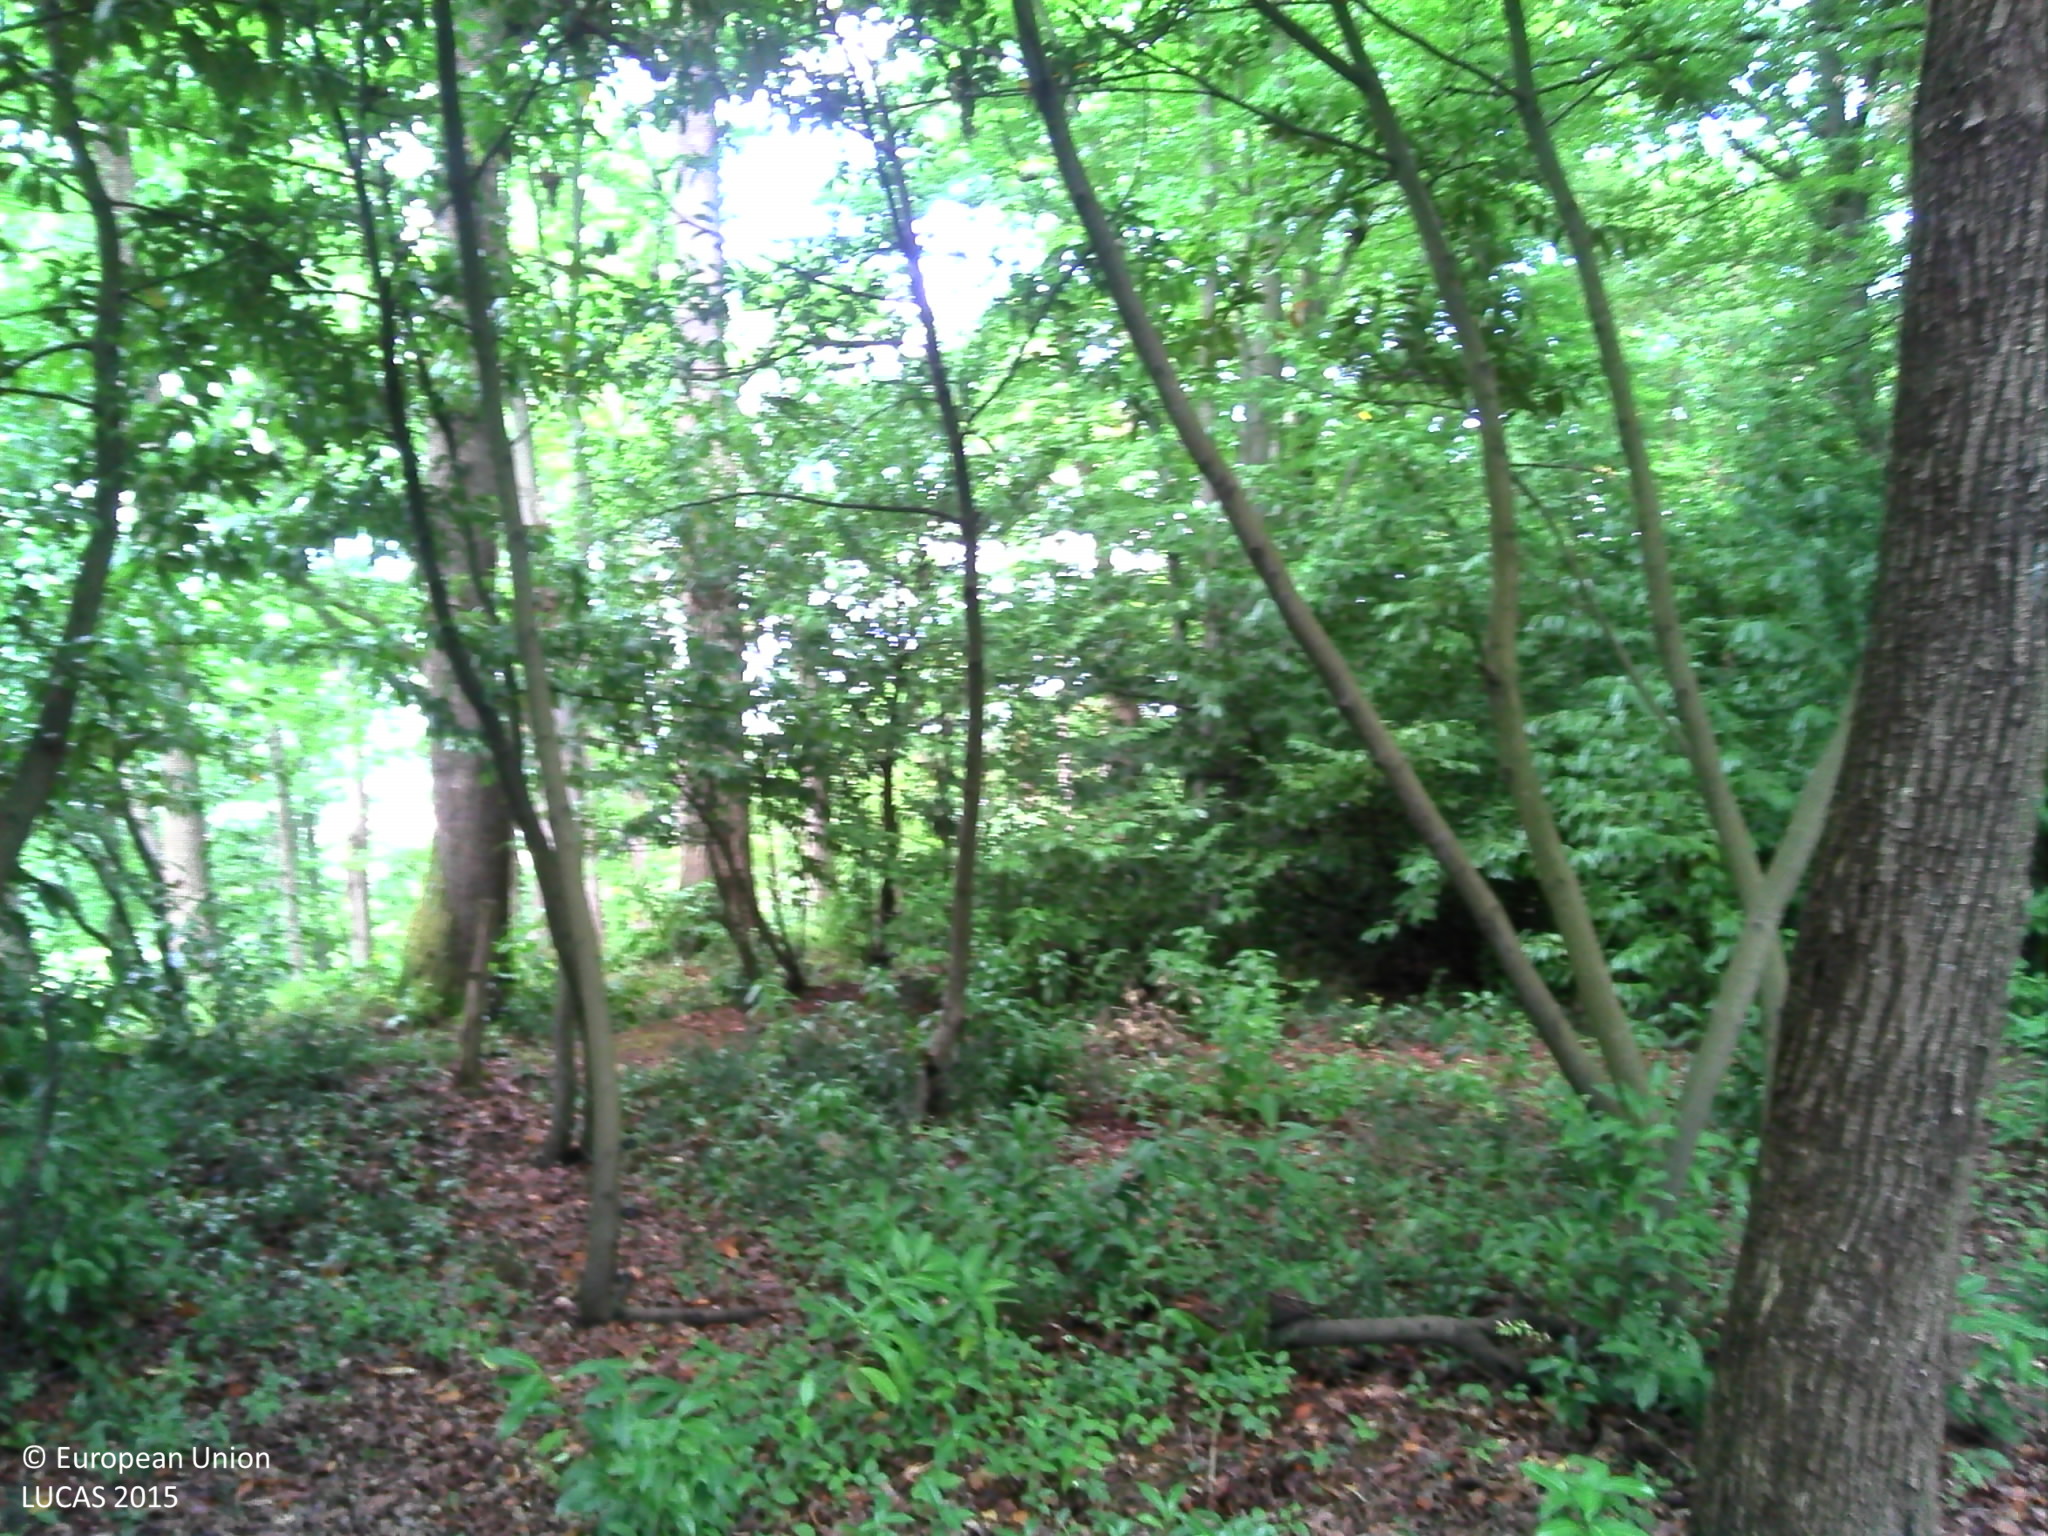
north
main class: Woodland
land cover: Broadleaved woodland
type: acidophilous oak and oak-birch forest
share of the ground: > 75 %
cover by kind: broadleaved forest trees 80 %, shrubs 10 %, herbaceous plants 5 %, lichens and mosses 5 %
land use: Forestry
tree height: > 5 m
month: September
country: FR
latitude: 43.2818
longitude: -0.3953
